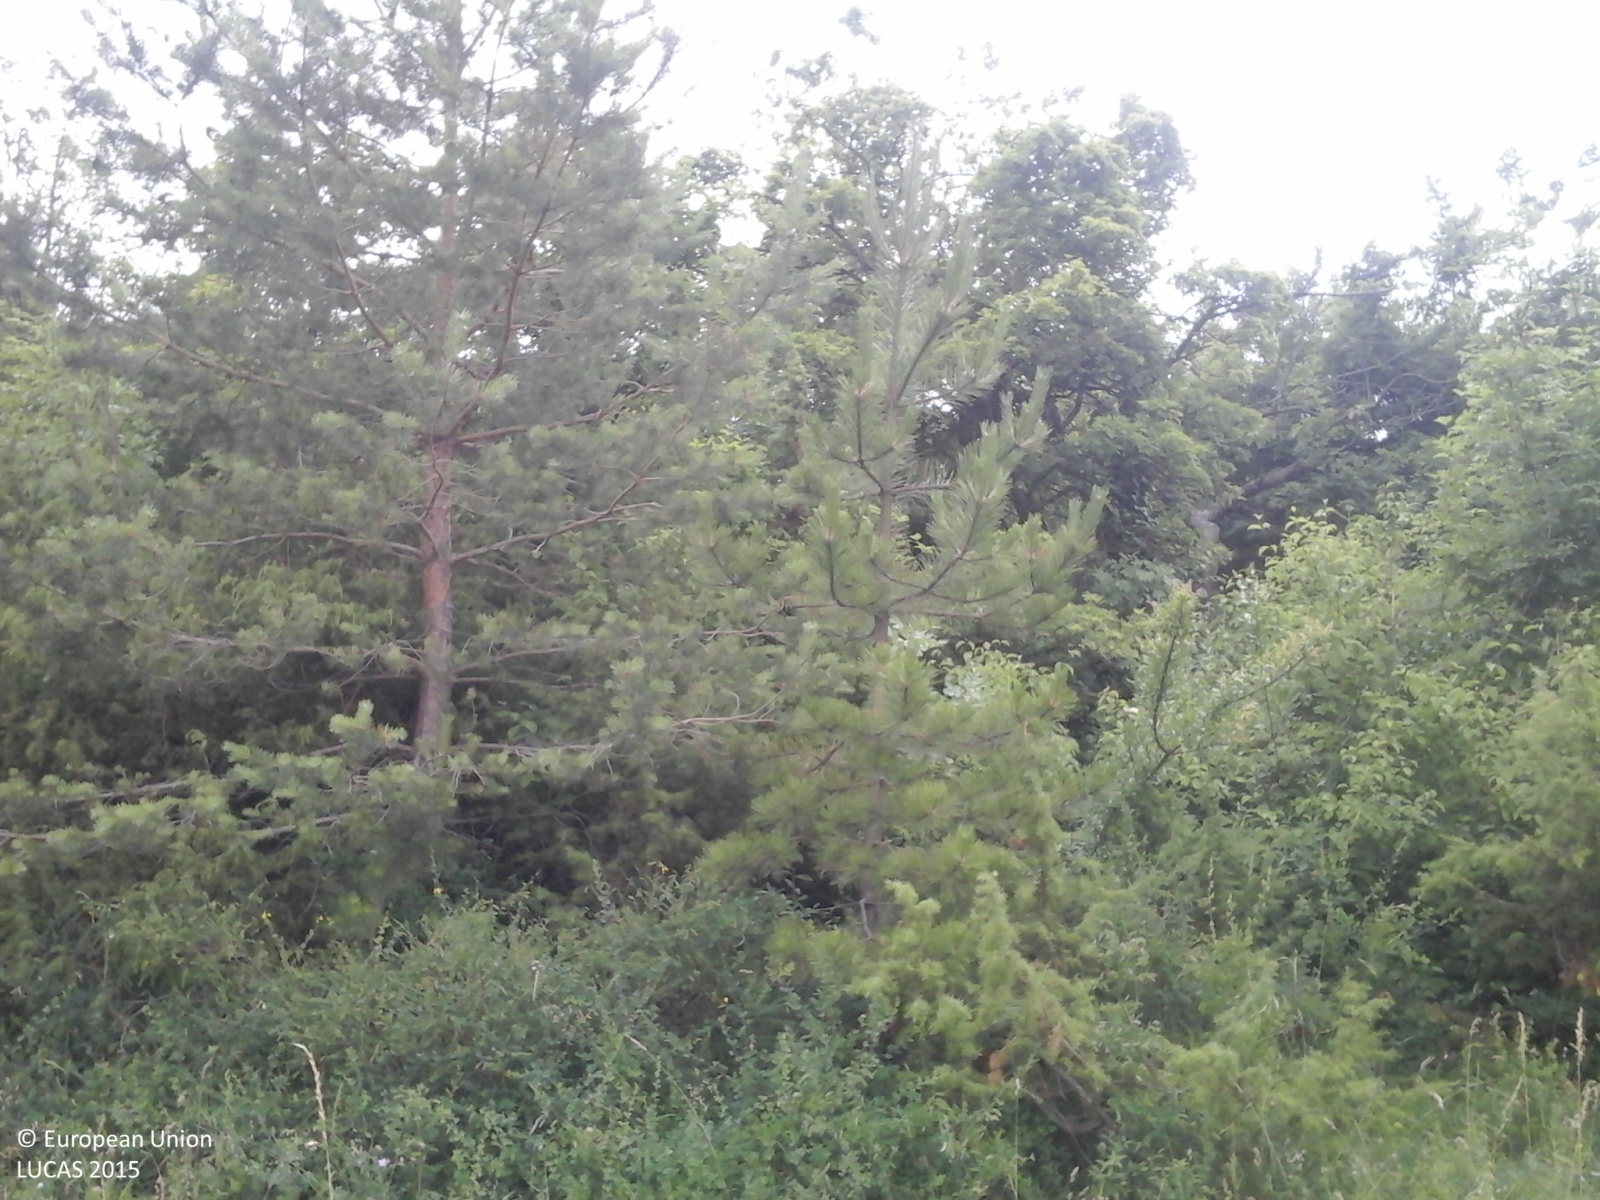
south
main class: Woodland
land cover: Pine dominated mixed woodland
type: alpine coniferous forest
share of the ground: > 75 %
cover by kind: coniferous forest trees 65 %, broadleaved forest trees 25 %, shrubs 5 %, herbaceous plants 5 %
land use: Forestry
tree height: > 5 m
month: June
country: IT
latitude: 44.5848
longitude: 10.2136
